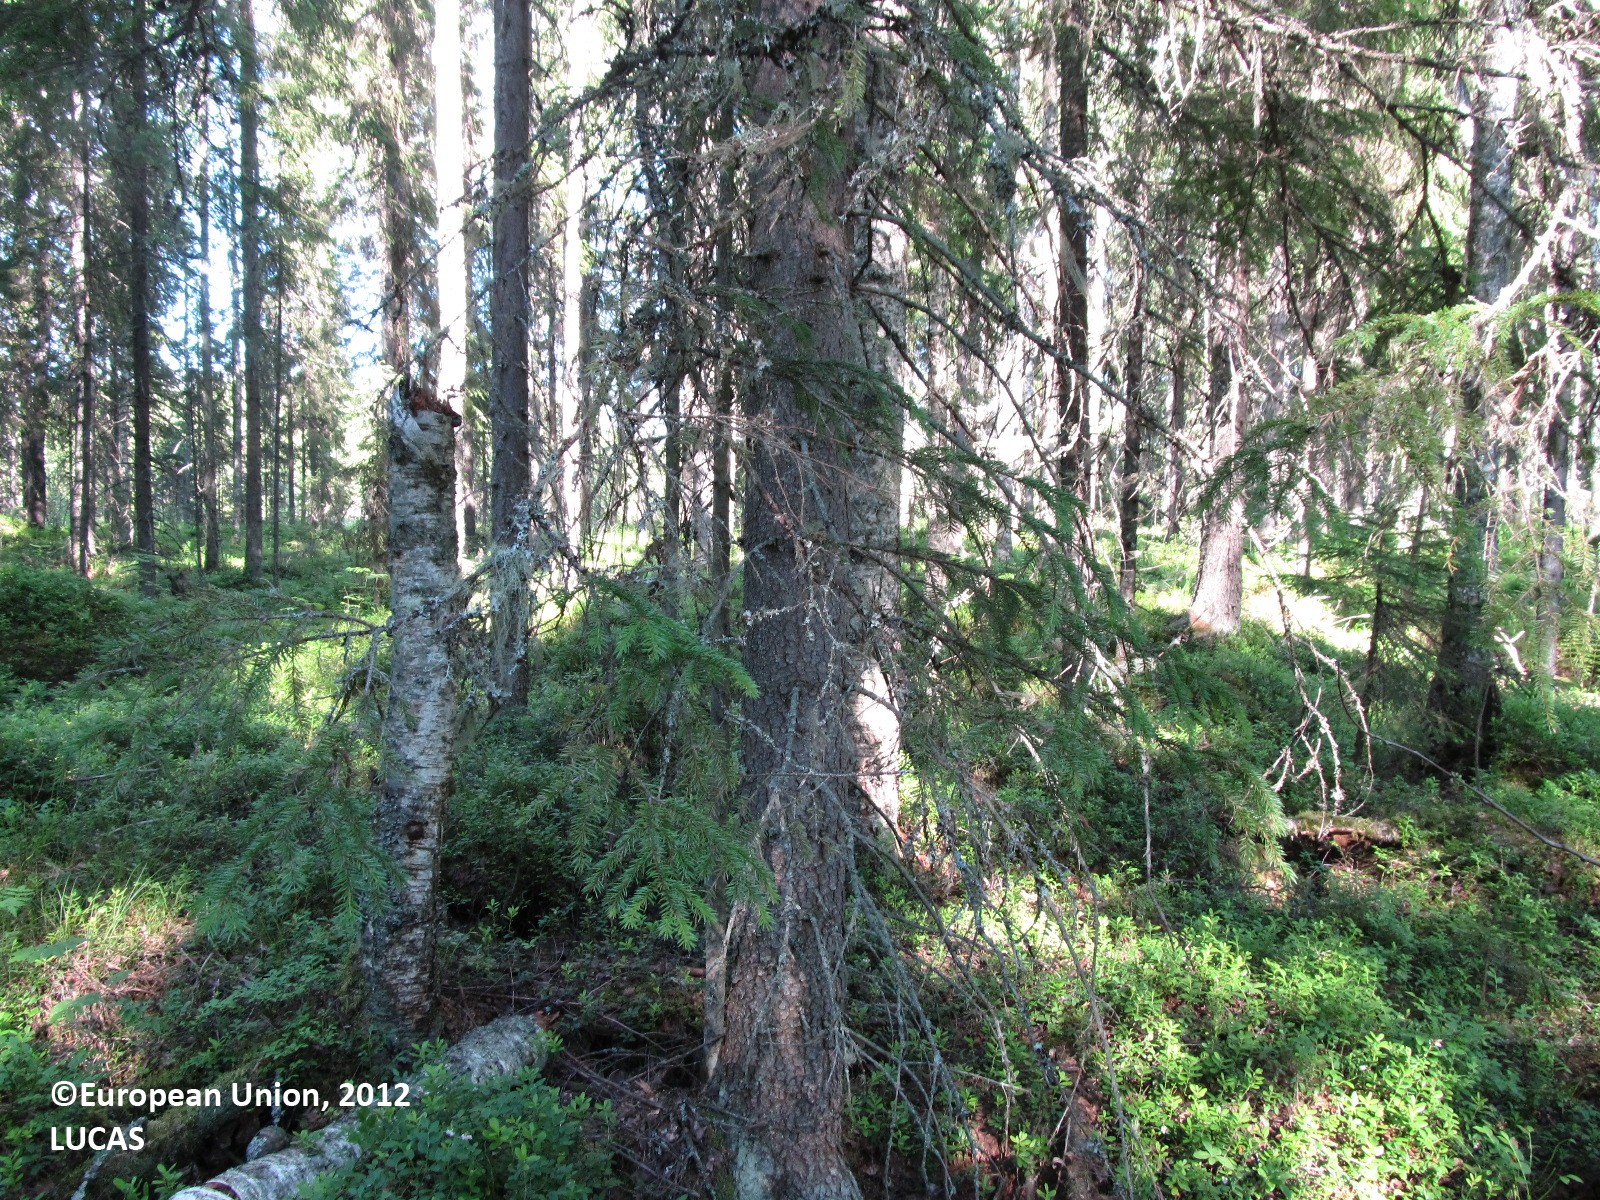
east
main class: Woodland
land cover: Spruce dominated coniferous woodland
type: boreal forest
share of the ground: 50 - 75 %
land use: Forestry
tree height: > 5 m
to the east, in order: Spruce dominated coniferous woodland; Spruce dominated mixed woodland
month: July
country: FI
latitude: 62.5603
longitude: 28.9897
